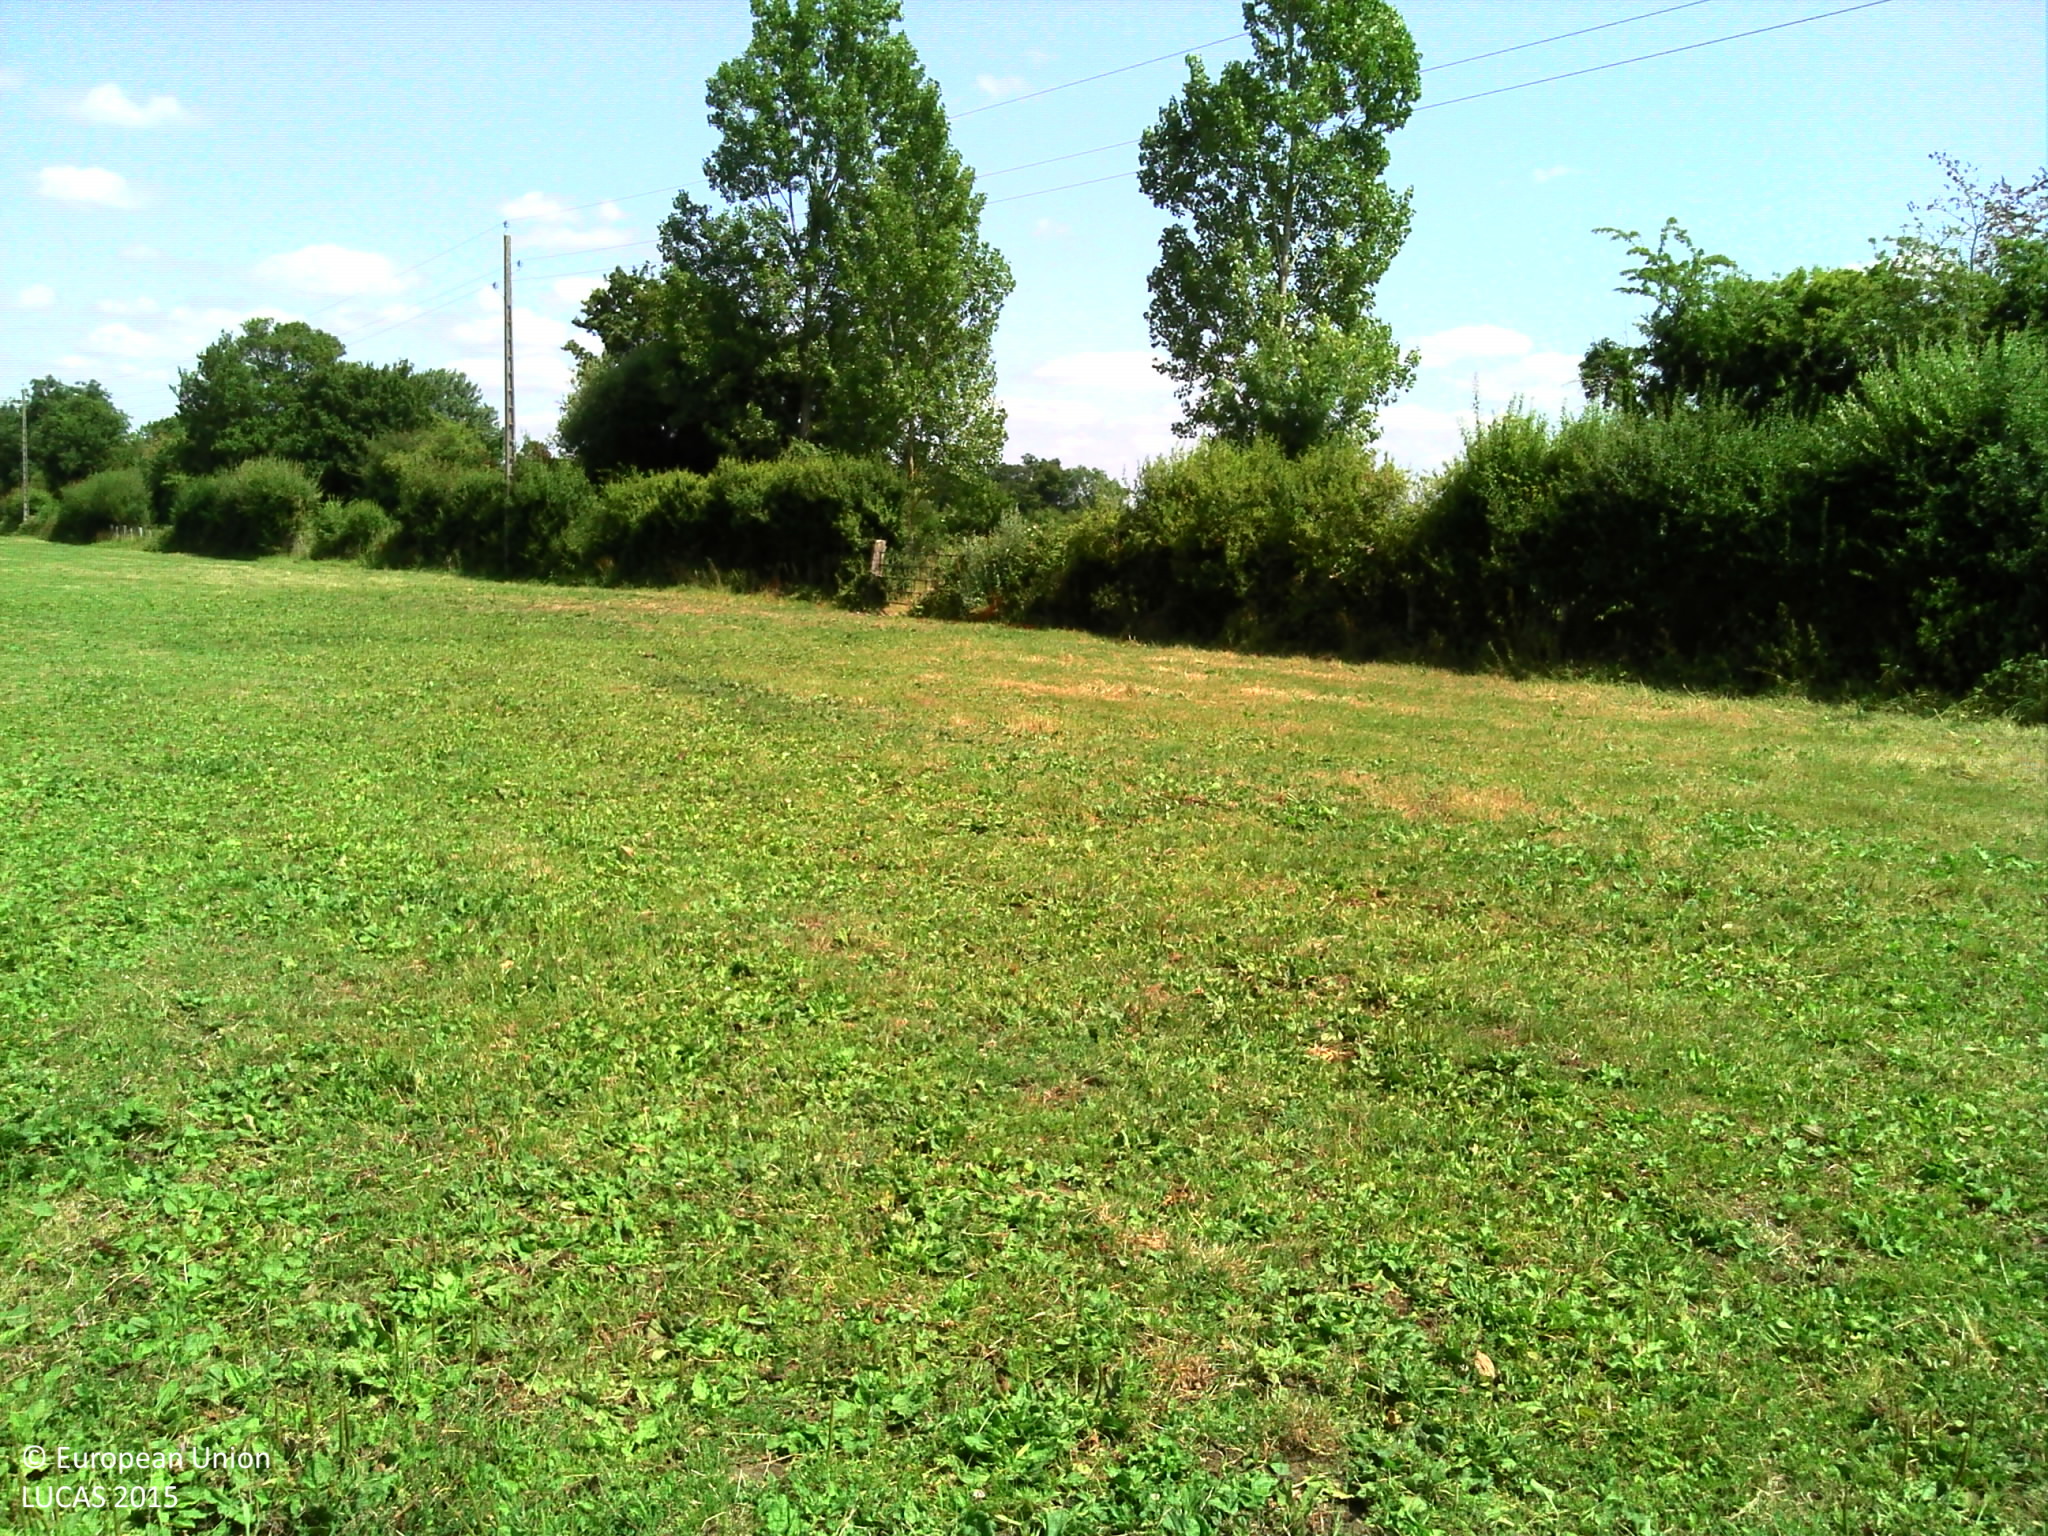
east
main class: Grassland
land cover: Grassland without tree/shrub cover
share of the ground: > 75 %
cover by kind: herbaceous plants 100 %
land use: Agriculture (excluding fallow land and kitchen gardens)
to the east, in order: Grassland without tree/shrub cover; Fences; Managed hedges; Ditches and canals; Electric lines; Grass margins; Paved roads, cycling and walking lanes; Grass margins; Broadleaved woodland; Fences; Grassland without tree/shrub cover; Fences; Abandoned hedges; Tracks; Fences; Grassland without tree/shrub cover
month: July
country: FR
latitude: 49.0898
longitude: -0.0136
